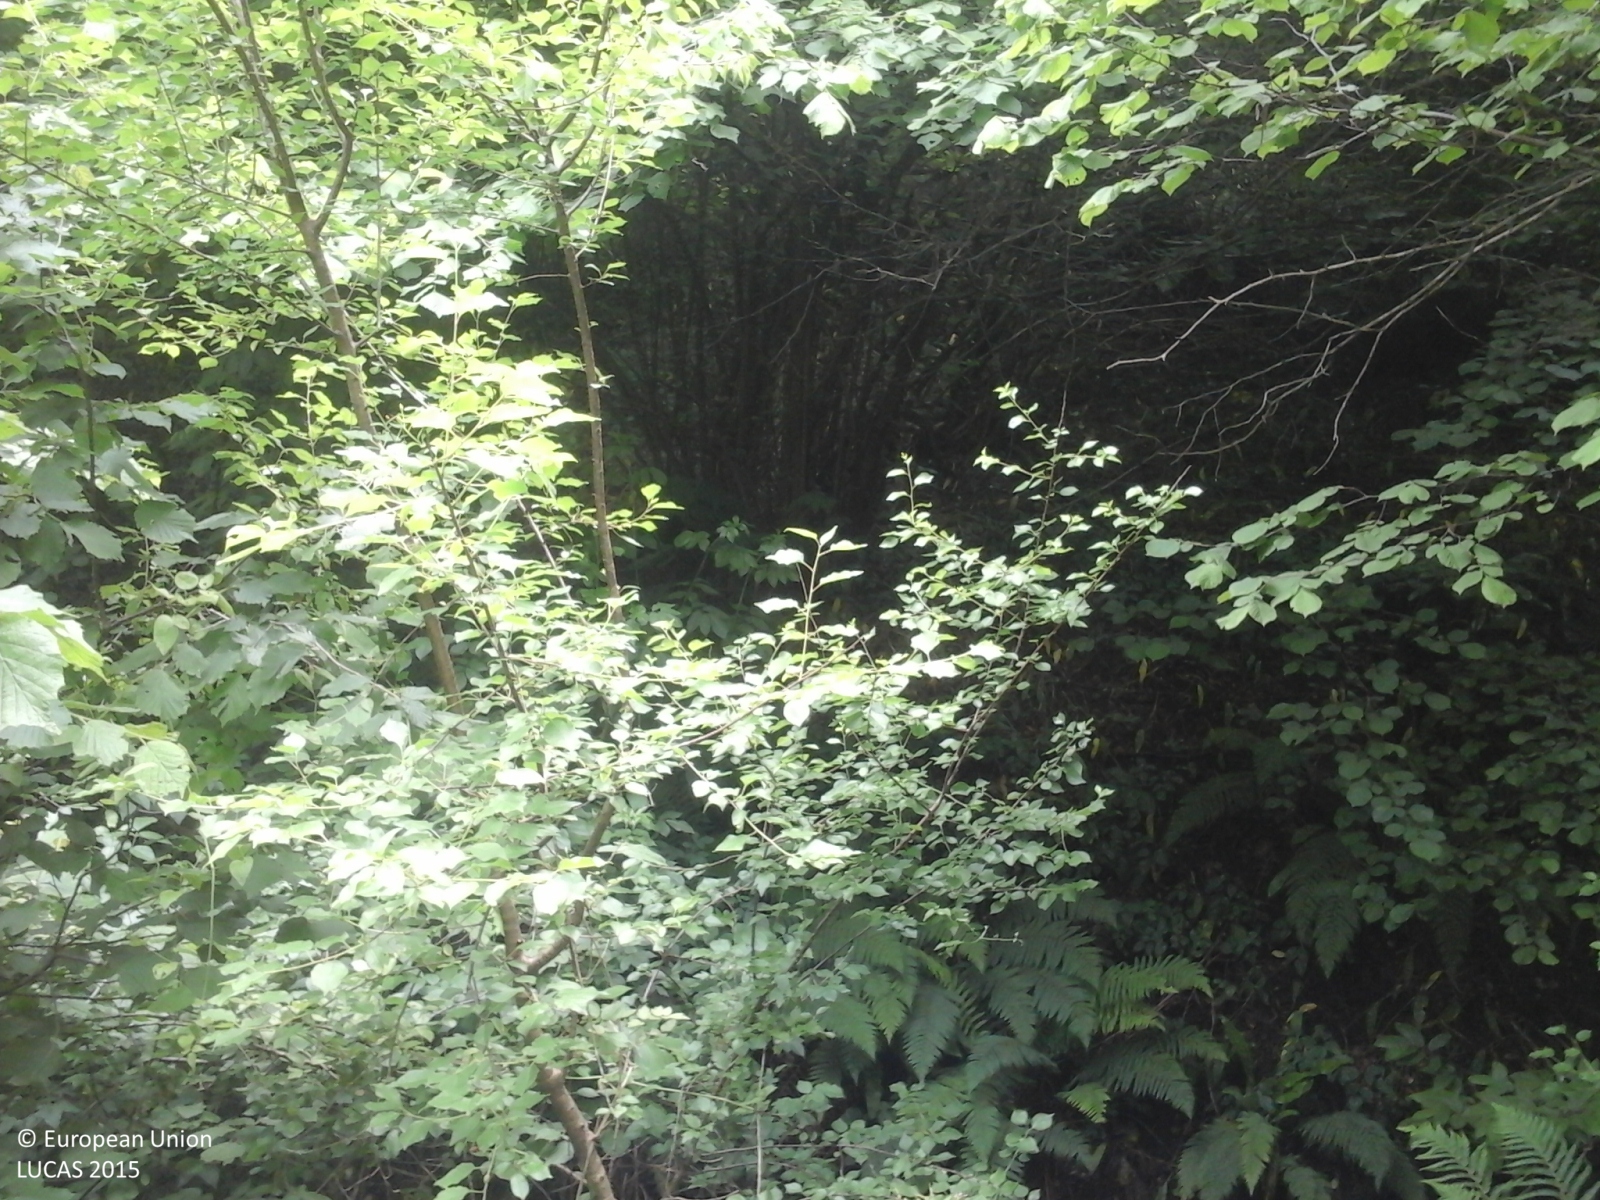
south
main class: Woodland
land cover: Broadleaved woodland
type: mire and swamp forests
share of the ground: > 75 %
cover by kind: broadleaved forest trees 100 %
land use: Forestry
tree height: > 5 m
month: May
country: IT
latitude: 45.4567
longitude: 11.5703
